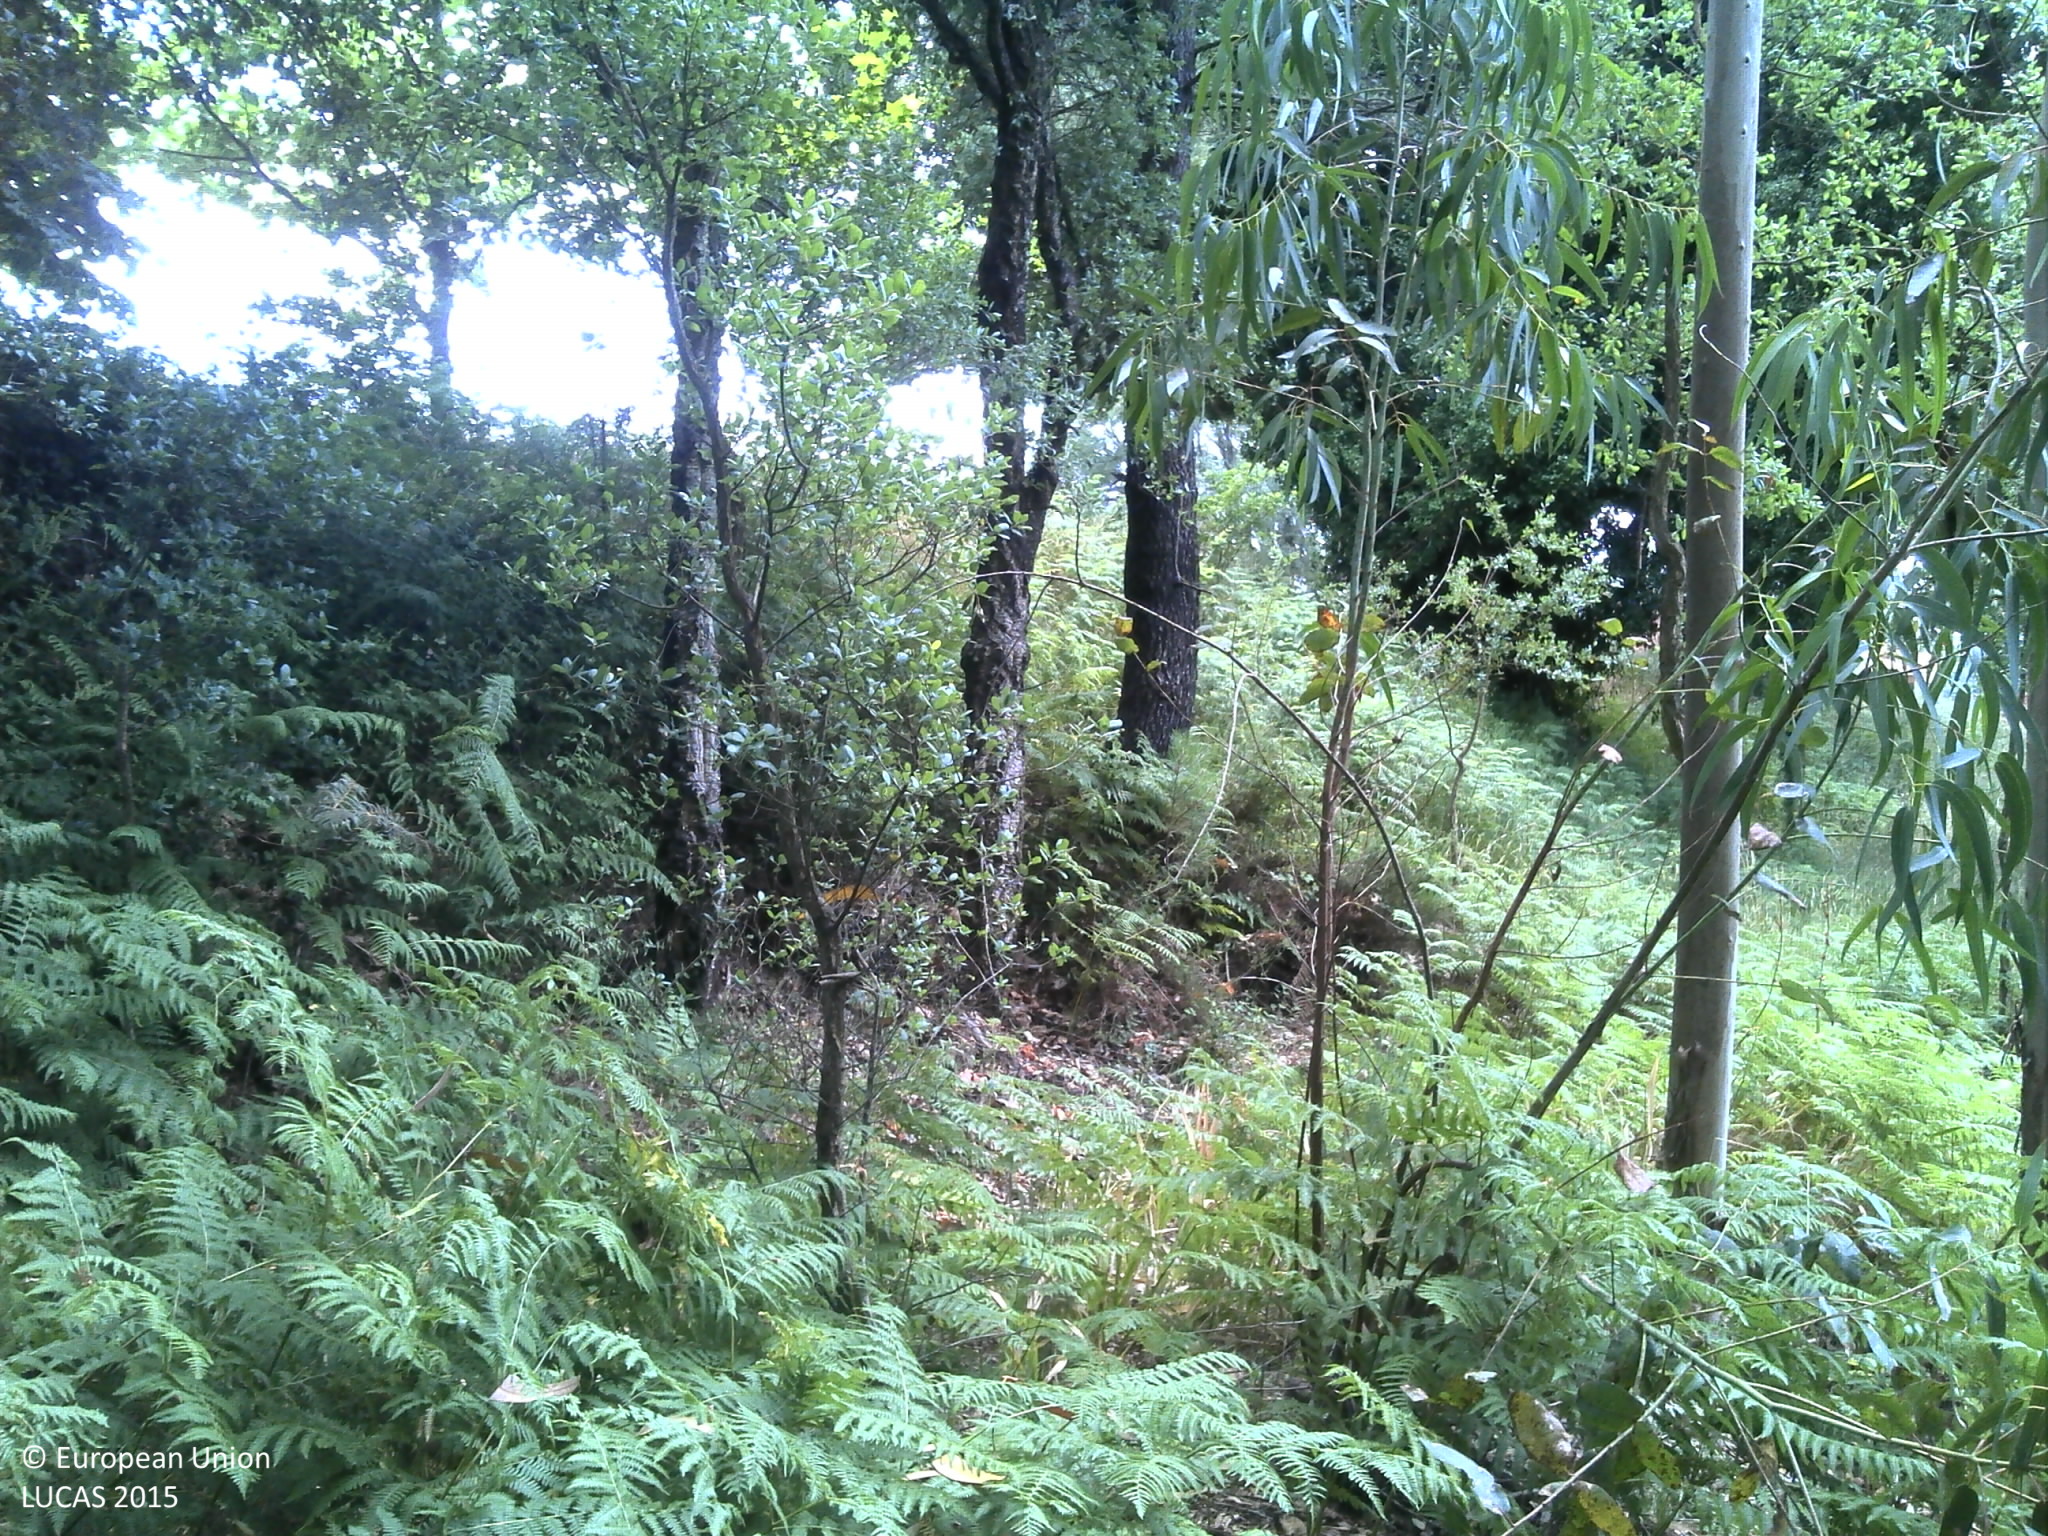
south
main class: Woodland
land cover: Broadleaved woodland
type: exotic forest
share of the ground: 50 - 75 %
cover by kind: broadleaved forest trees 65 %, shrubs 20 %, unconsolidated bare surface 15 %
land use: Forestry
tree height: > 5 m
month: June
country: PT
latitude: 40.7057
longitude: -8.3286
